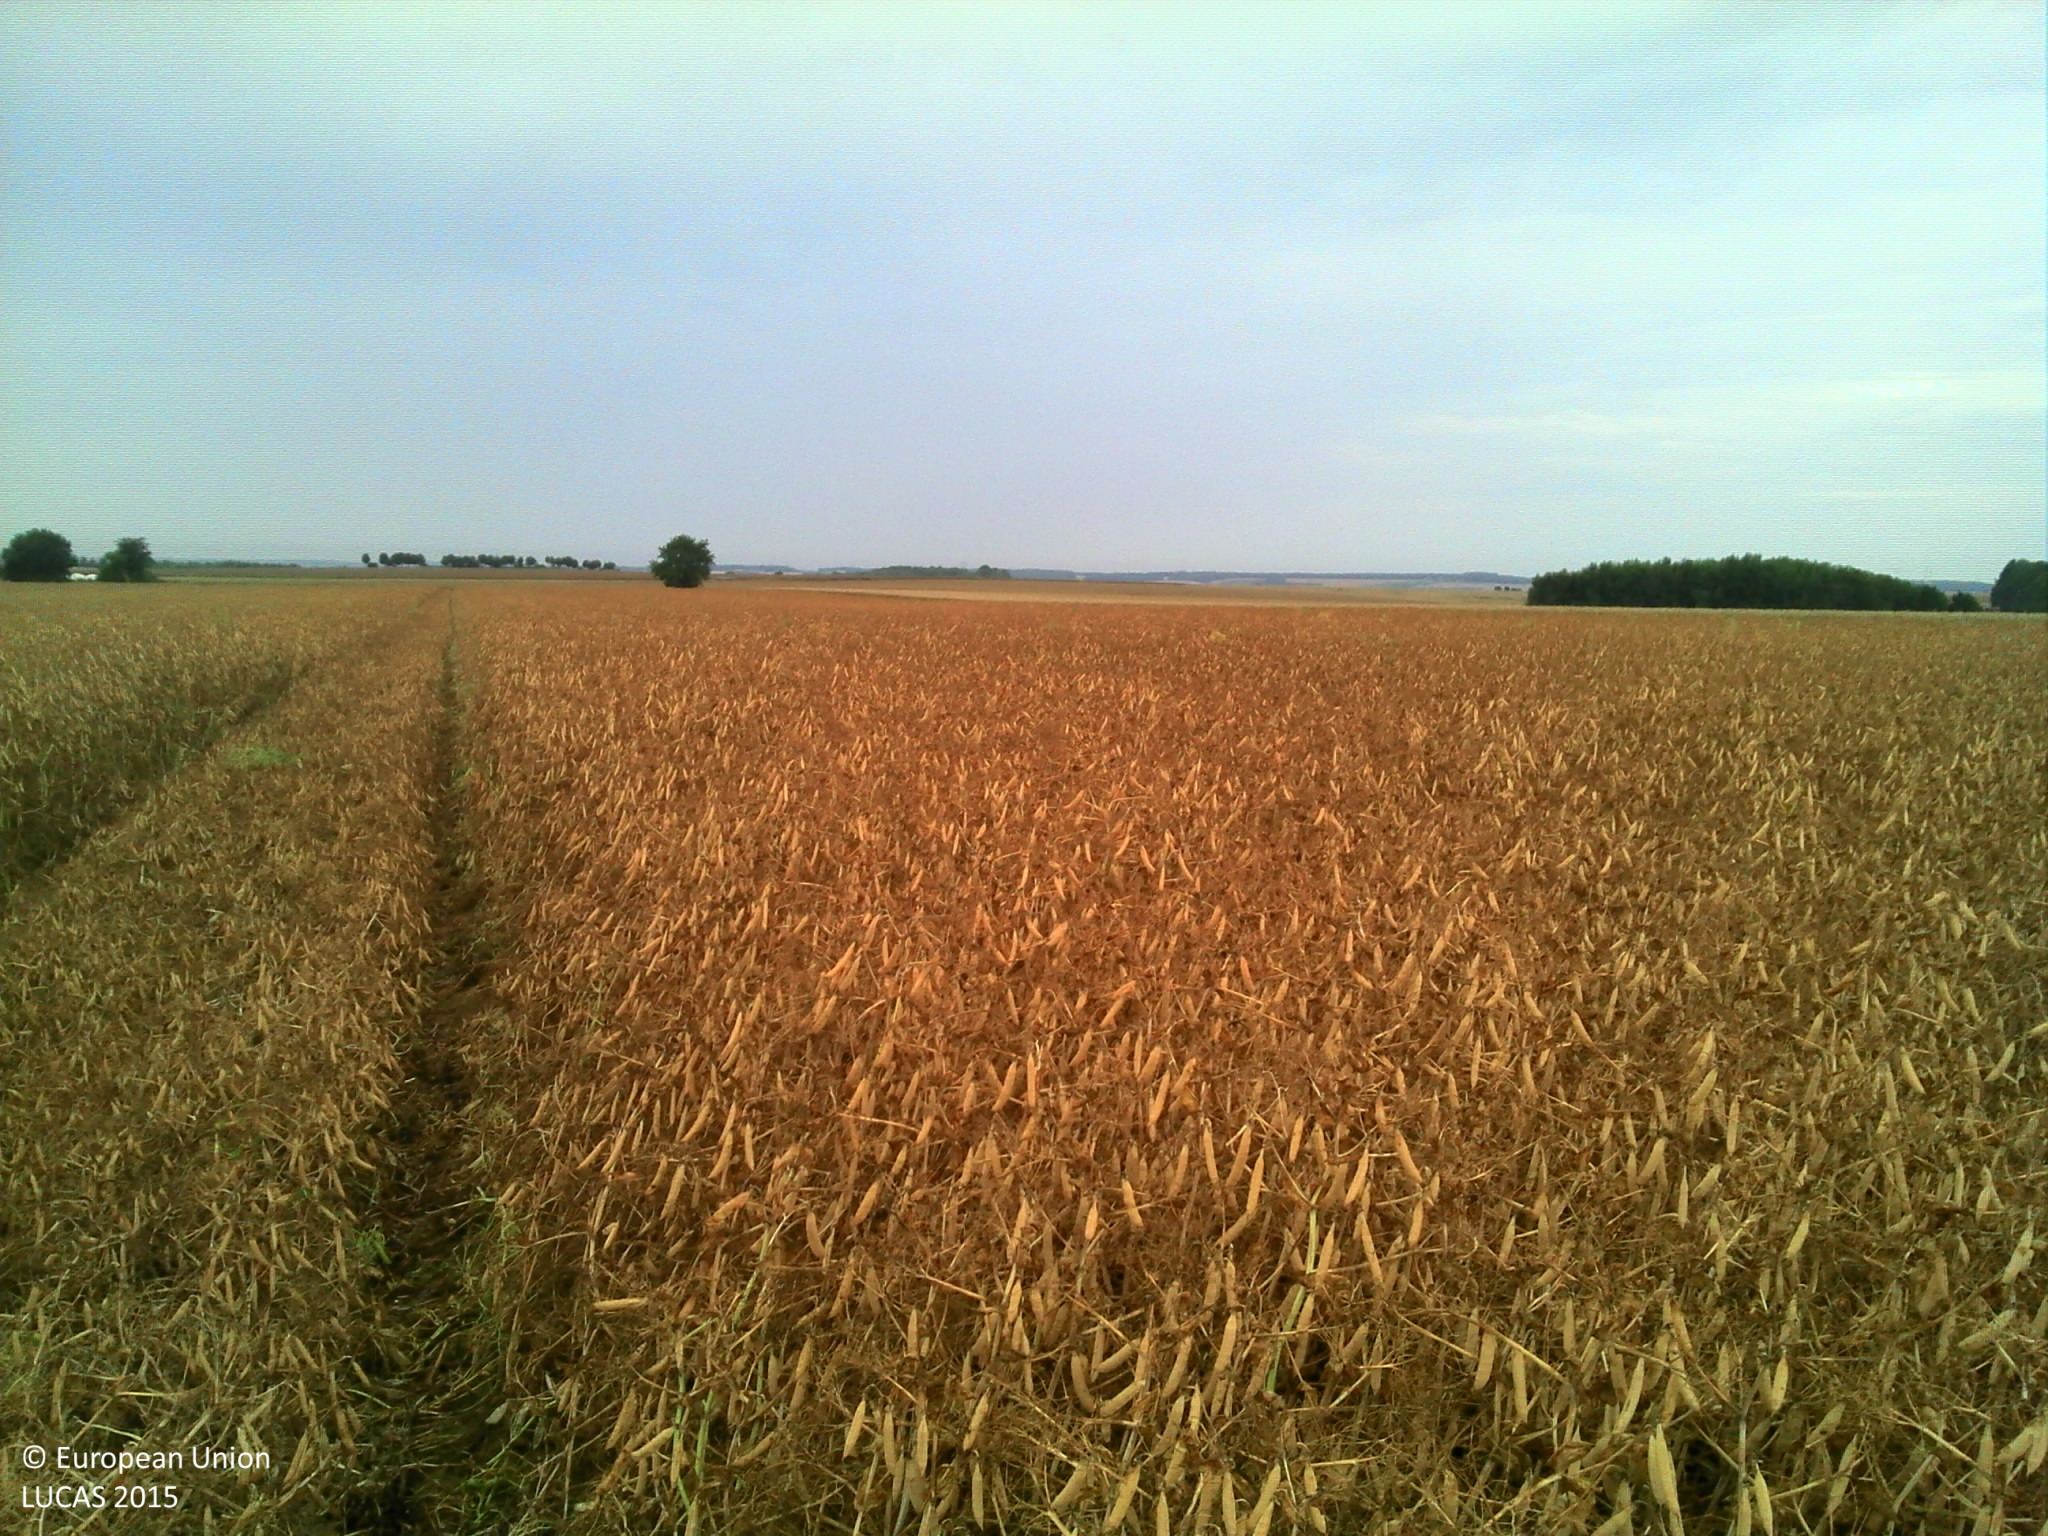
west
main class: Cropland
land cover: Dry pulses
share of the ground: > 75 %
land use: Agriculture (excluding fallow land and kitchen gardens)
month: July
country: FR
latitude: 50.0241
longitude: 2.1831
